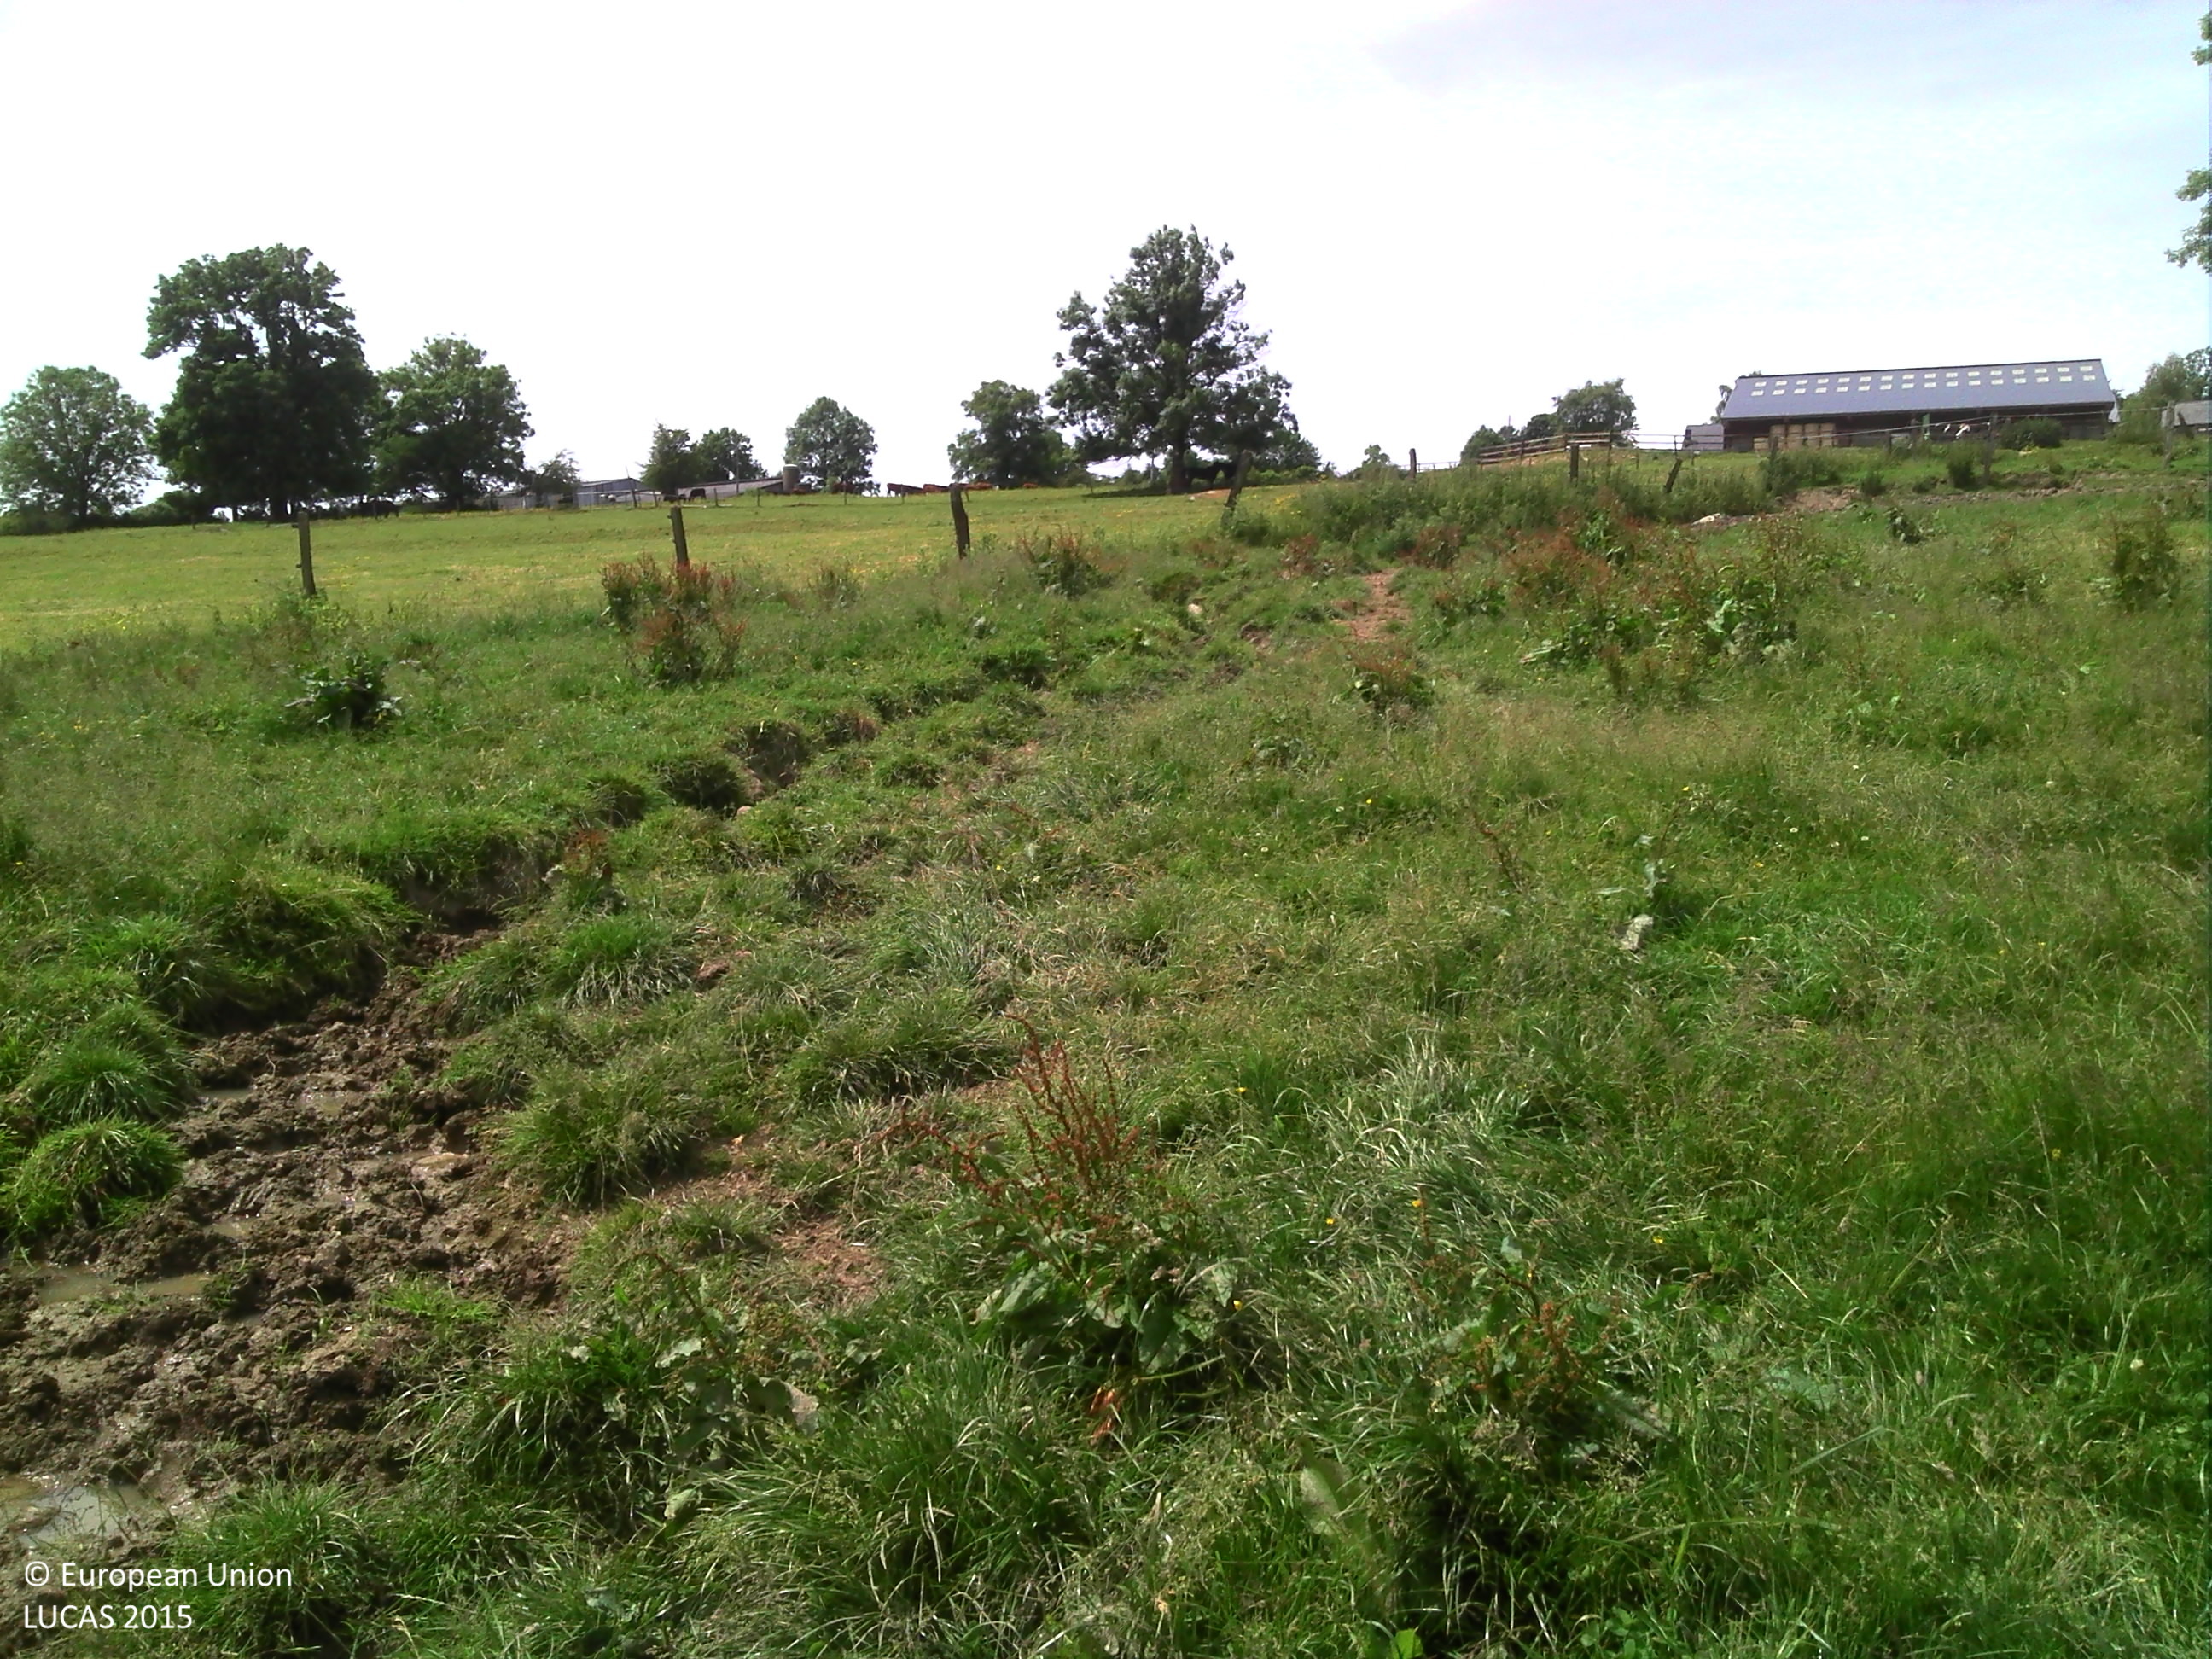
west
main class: Grassland
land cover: Grassland without tree/shrub cover
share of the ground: > 75 %
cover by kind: herbaceous plants 100 %
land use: Agriculture (excluding fallow land and kitchen gardens)
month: June
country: BE
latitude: 50.4337
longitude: 5.8738
